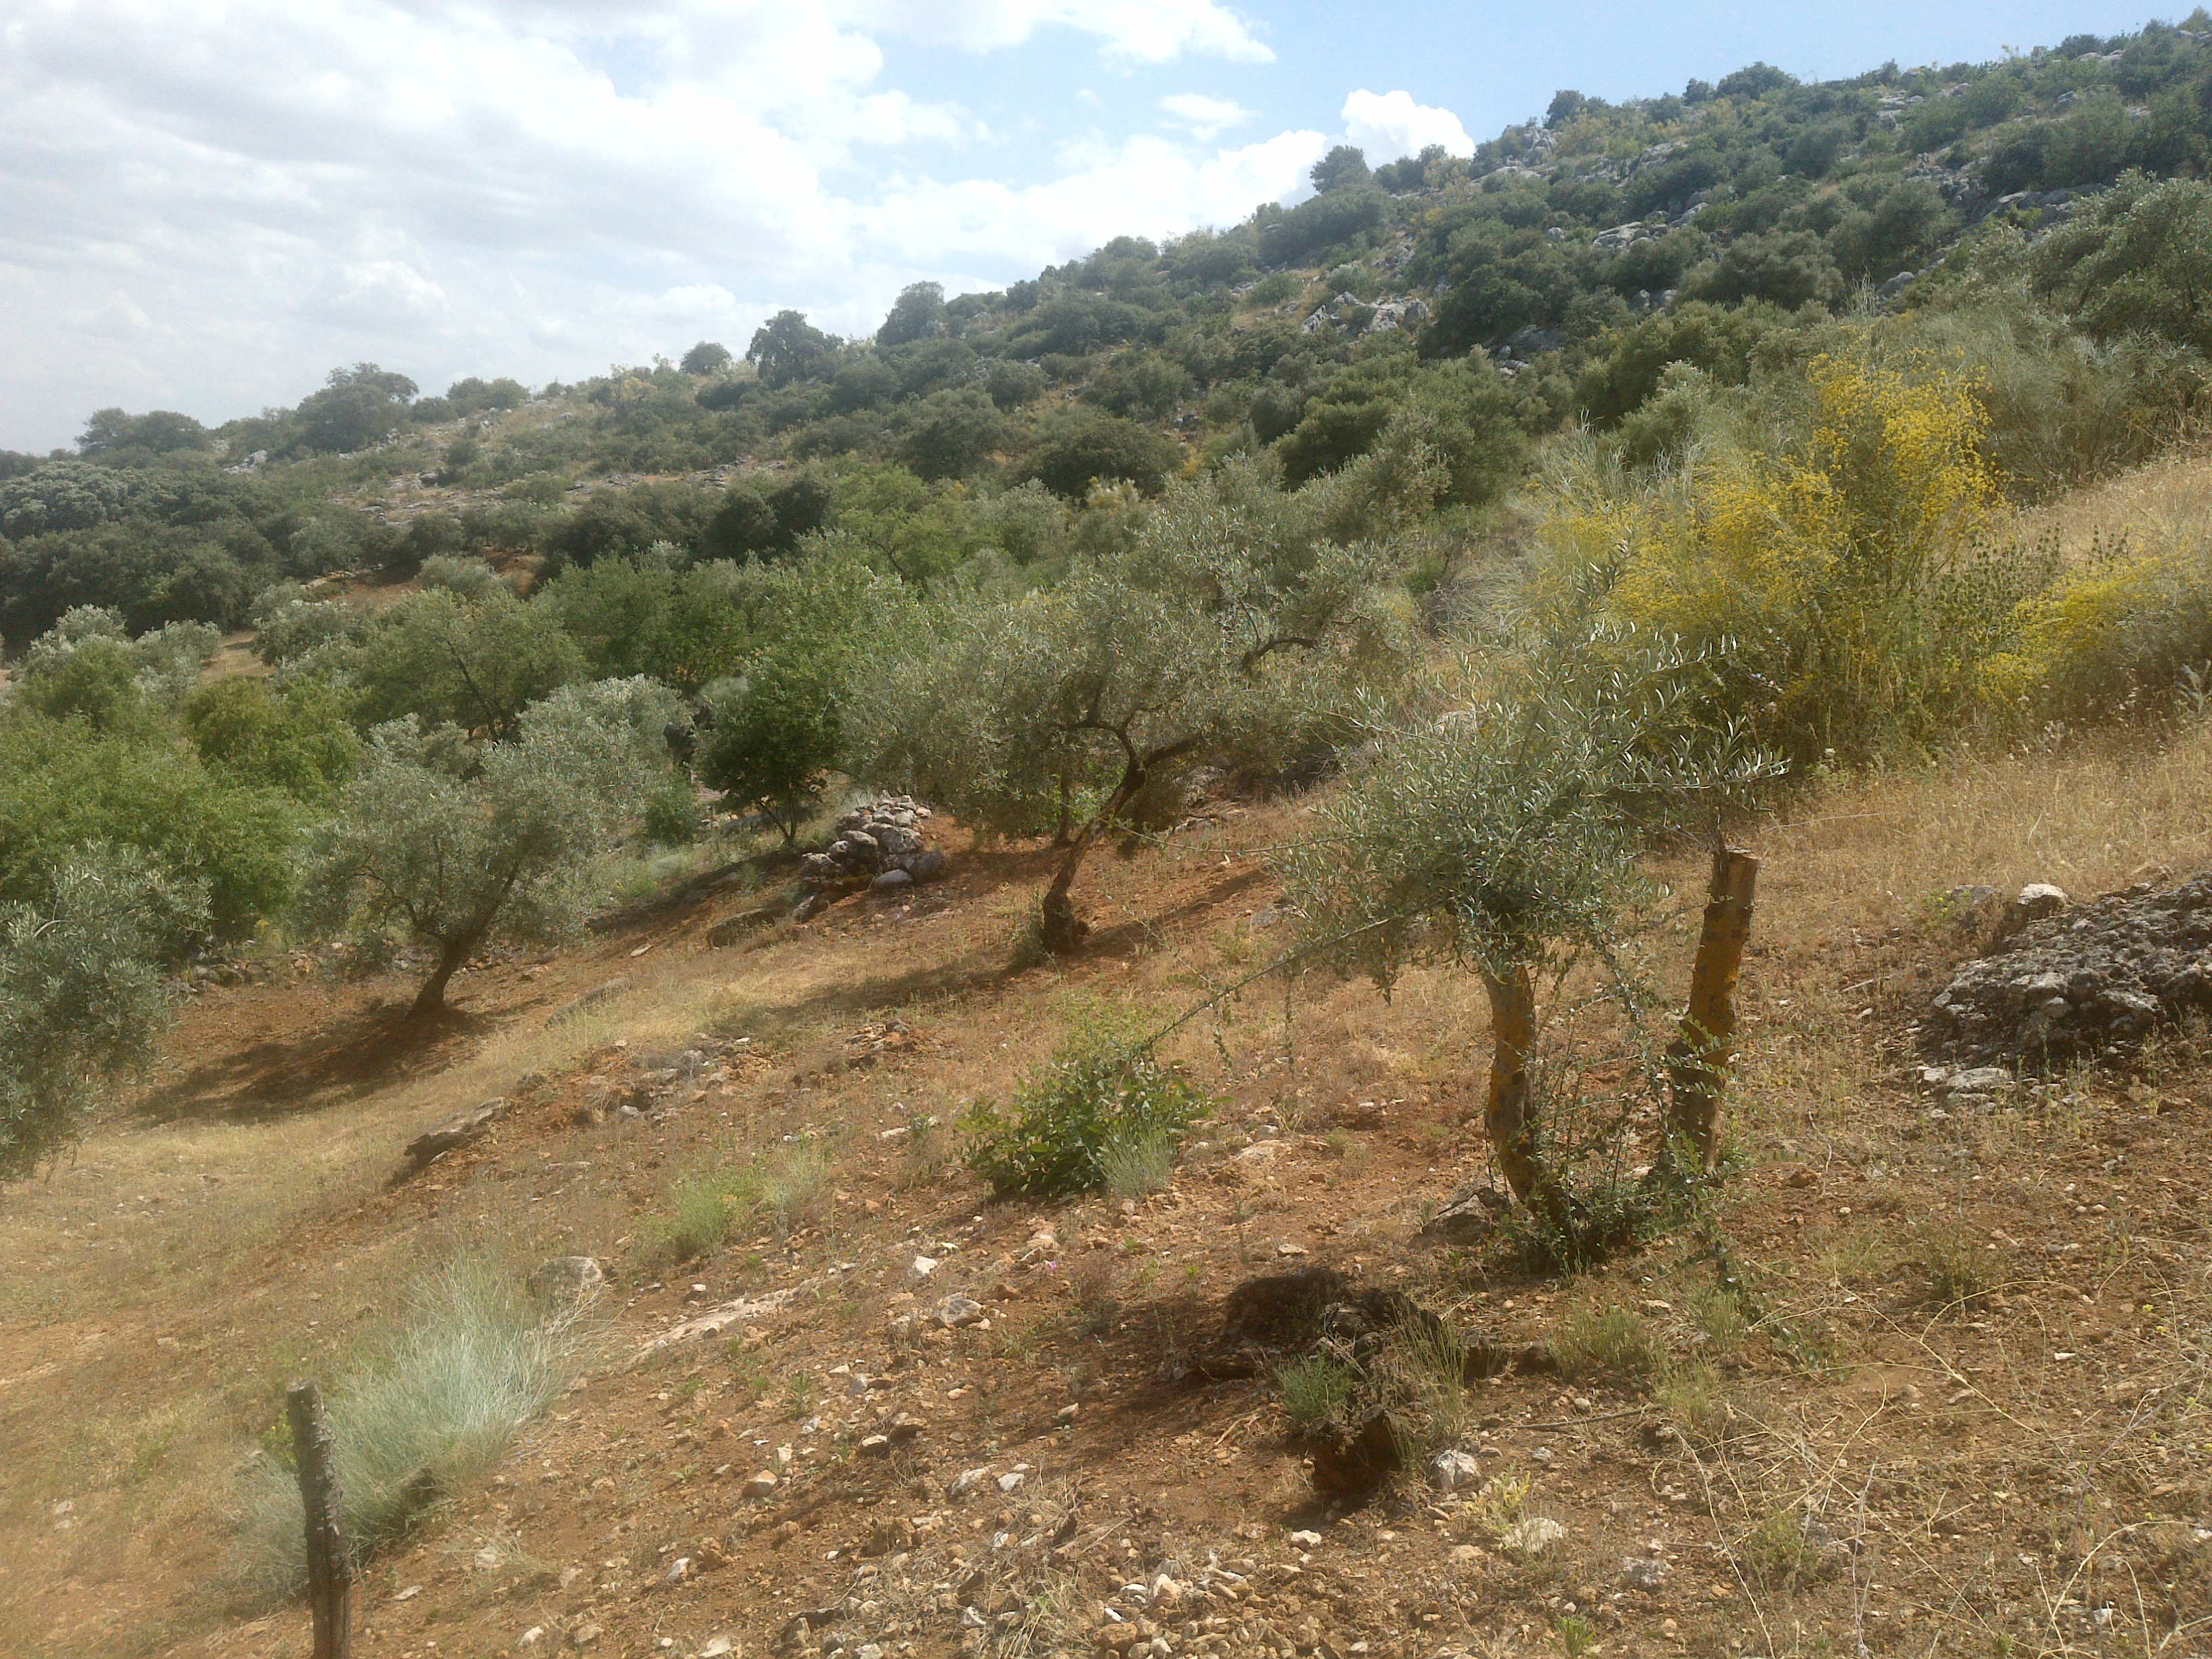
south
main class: Shrubland
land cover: Shrubland with sparse tree cover
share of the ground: 25 - 50 %
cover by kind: herbaceous plants 50 %, shrubs 25 %, unconsolidated bare surface 20 %, broadleaved forest trees 5 %
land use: Semi-natural and natural areas not in use
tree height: < 5 m
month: May
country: ES
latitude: 37.4968
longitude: -4.2418
